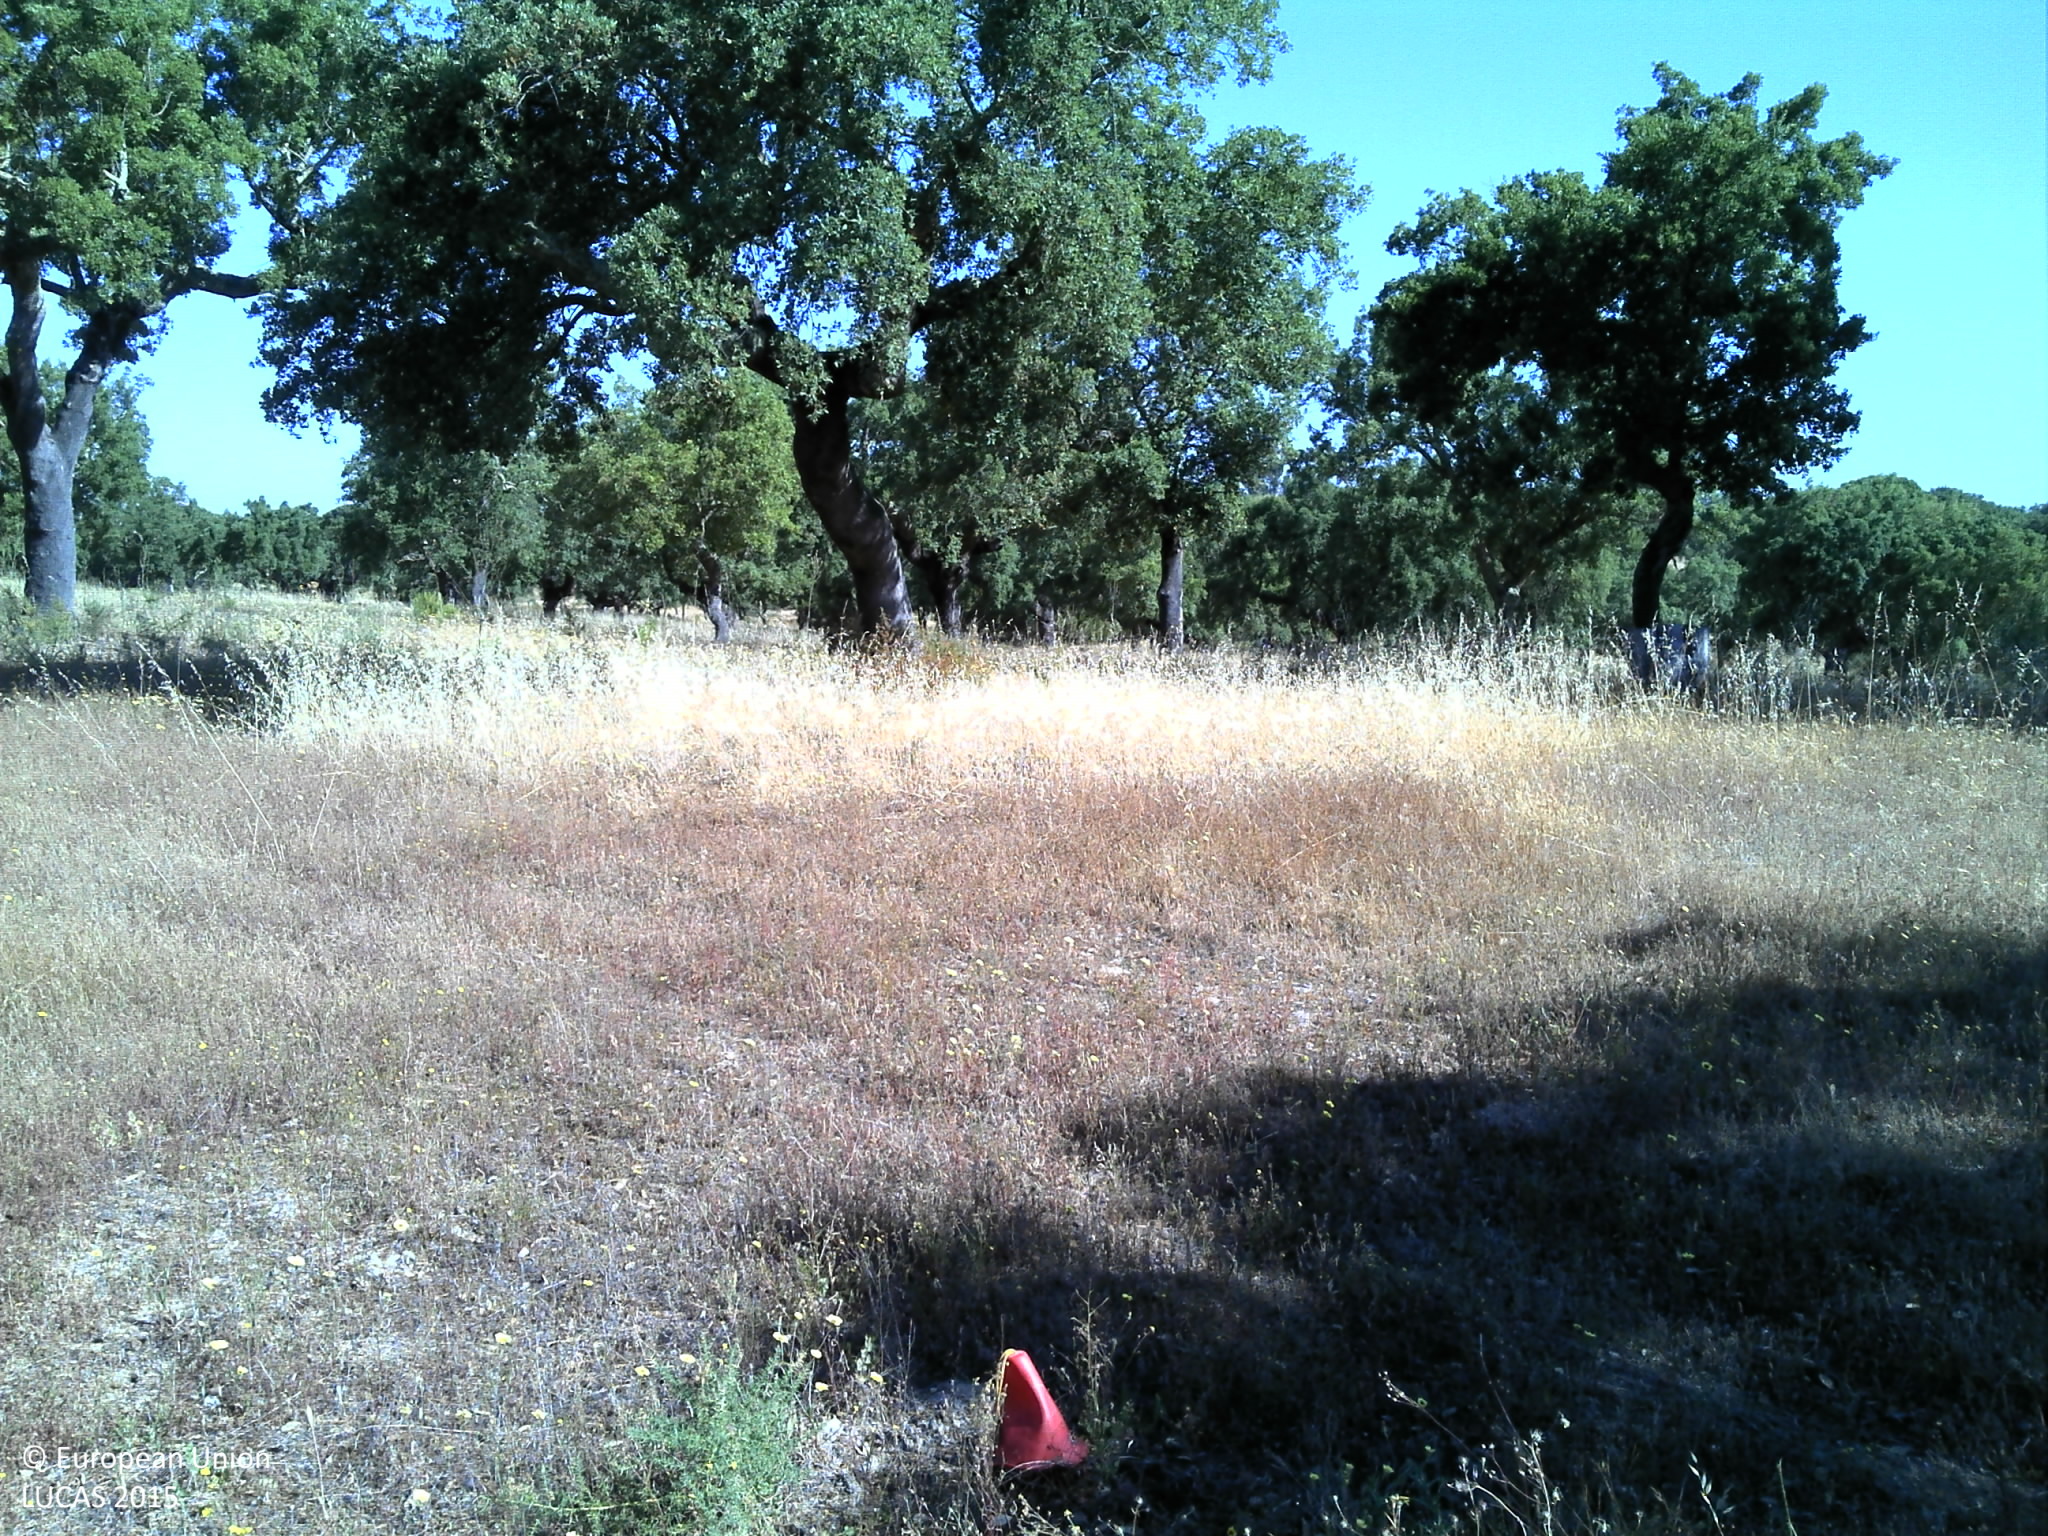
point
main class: Woodland
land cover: Broadleaved woodland
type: broadleaved evergreen forest
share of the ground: 25 - 50 %
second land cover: Grassland without tree/shrub cover
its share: 25 - 50 %
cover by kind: broadleaved forest trees 40 %, herbaceous plants 30 %, unconsolidated bare surface 30 %
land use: Forestry
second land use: Agriculture (excluding fallow land and kitchen gardens)
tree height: > 5 m
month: May
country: PT
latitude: 38.9280
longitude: -8.1508
